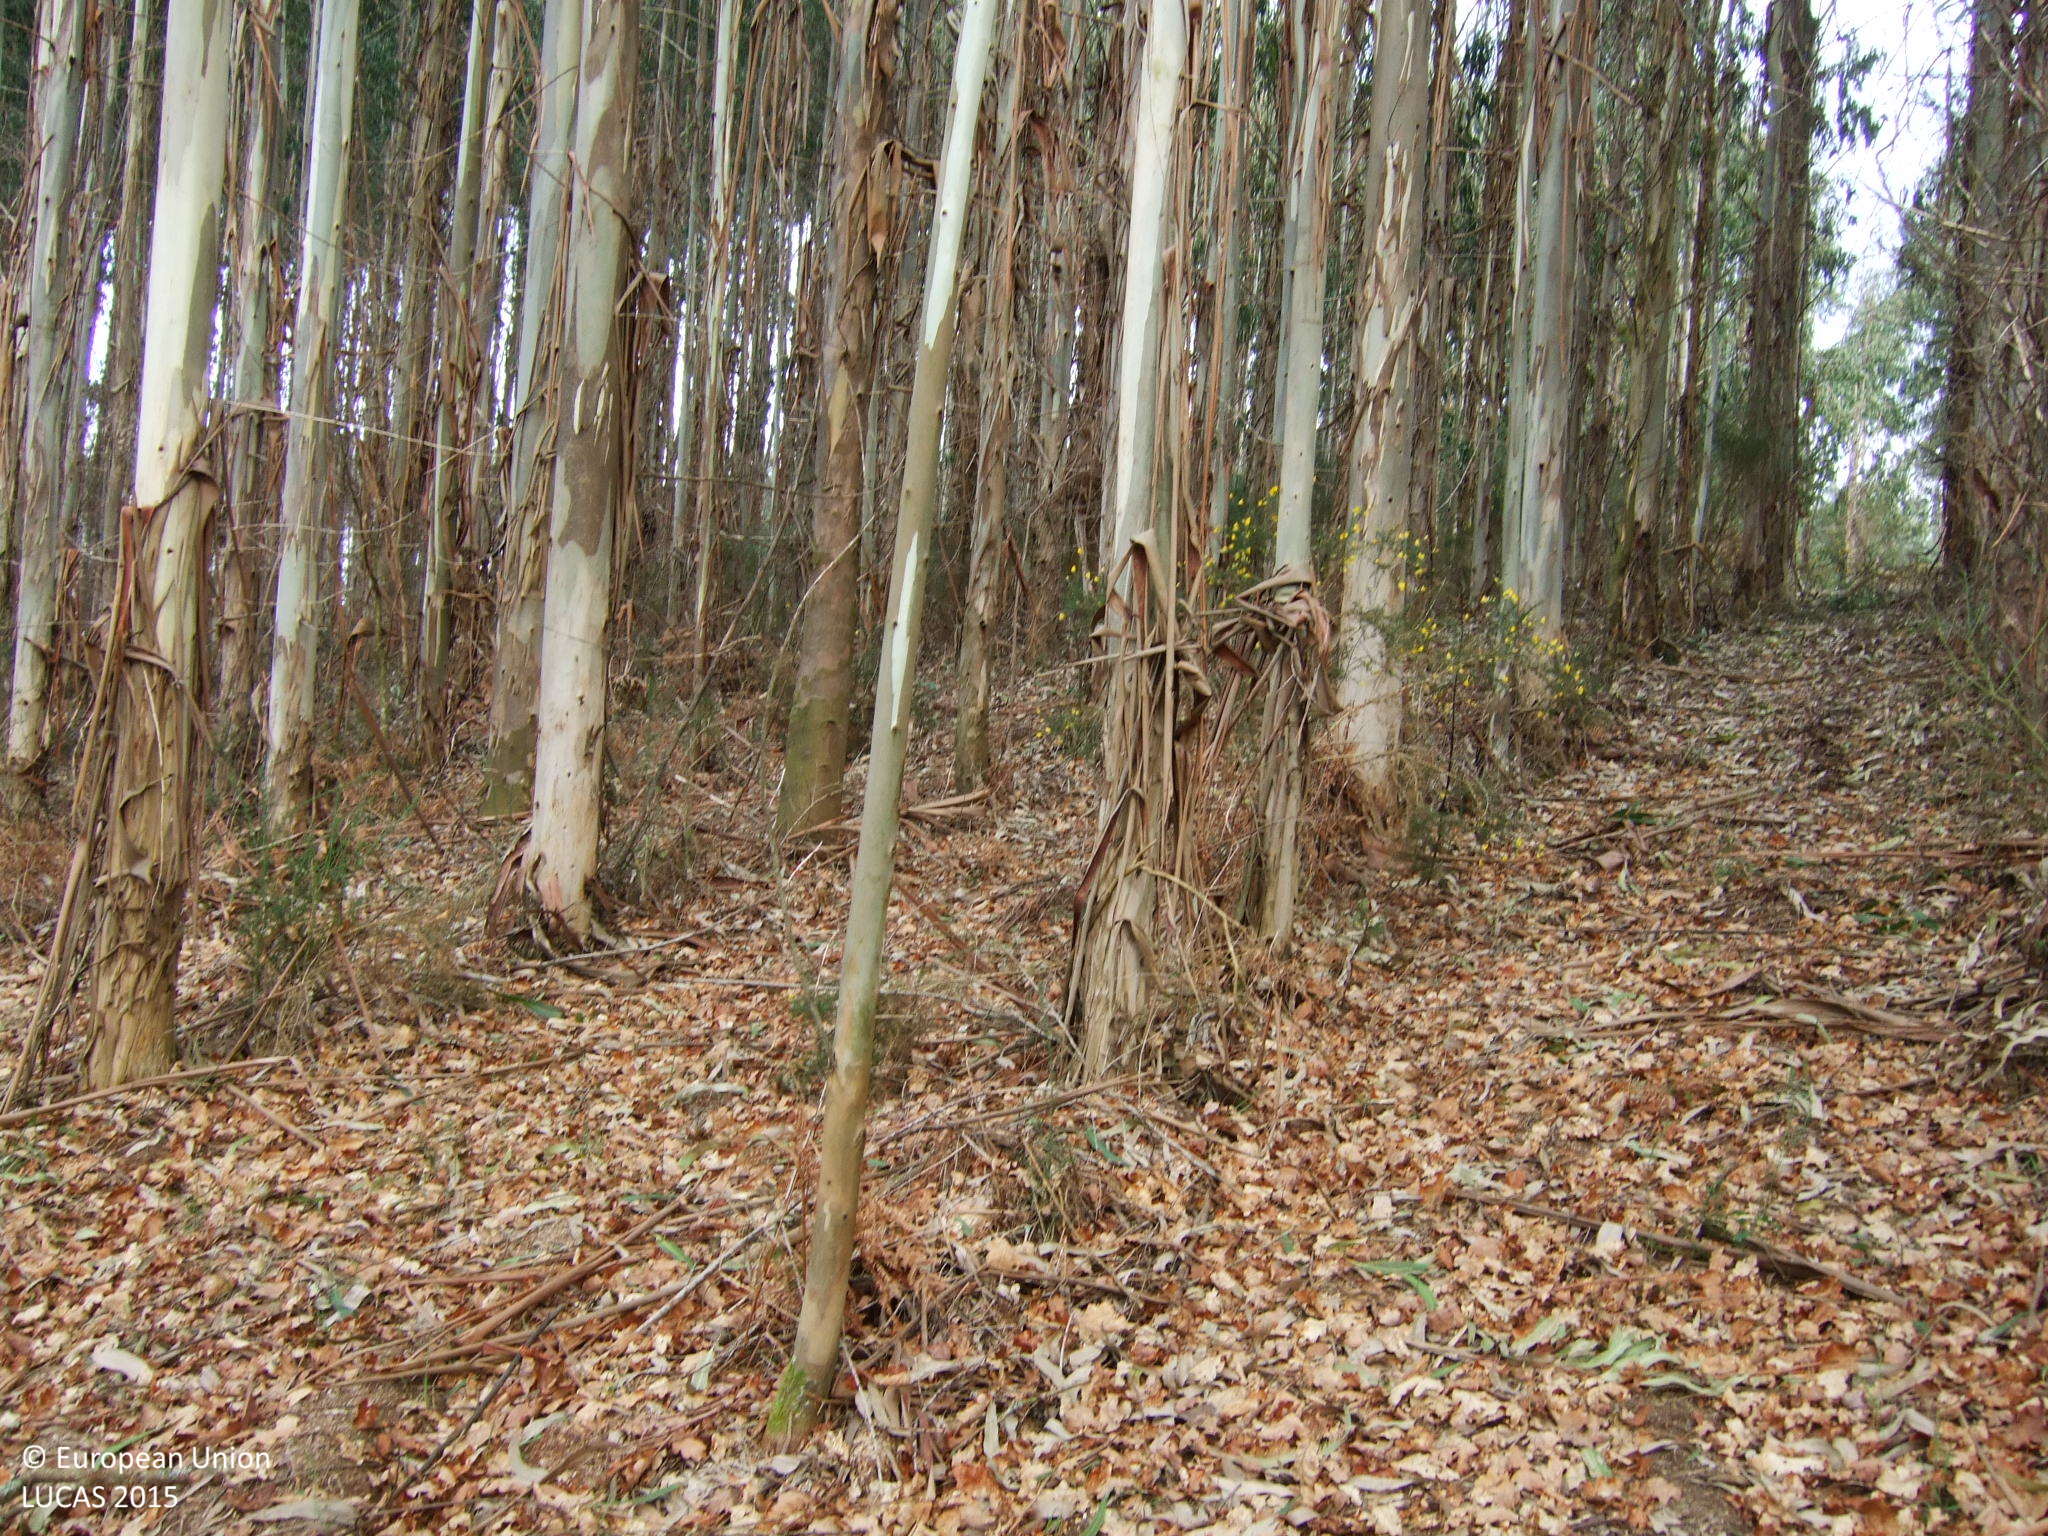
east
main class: Woodland
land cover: Broadleaved woodland
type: exotic forest
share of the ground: > 75 %
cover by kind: broadleaved forest trees 80 %, shrubs 20 %
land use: Forestry
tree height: > 5 m
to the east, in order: Broadleaved woodland; Shruby margins; Broadleaved woodland; Shruby margins; Broadleaved woodland; Dry stone walls; Pine dominated coniferous woodland
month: March
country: ES
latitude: 42.8321
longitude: -7.9092
